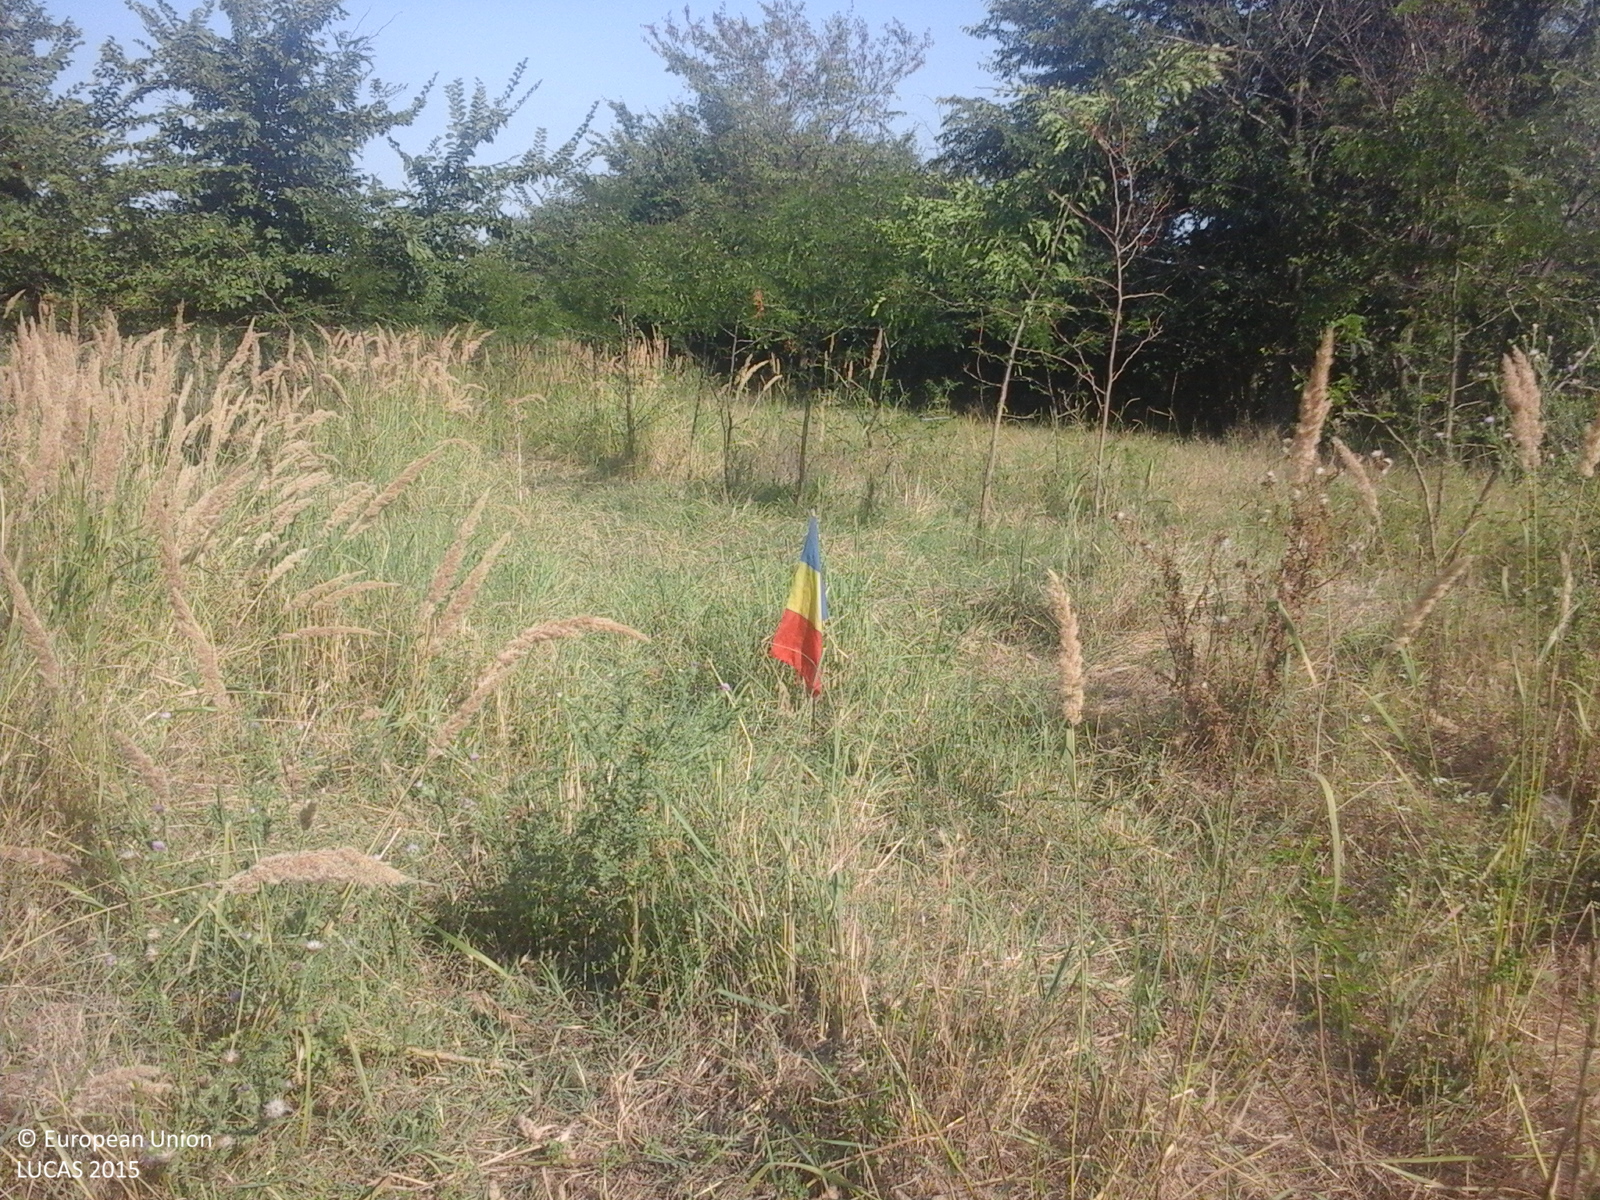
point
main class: Grassland
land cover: Grassland with sparse tree/shrub cover
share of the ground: > 75 %
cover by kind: herbaceous plants 90 %, broadleaved forest trees 5 %, shrubs 5 %
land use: Agriculture (excluding fallow land and kitchen gardens)
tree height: < 5 m
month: July
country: RO
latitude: 44.6319
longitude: 27.6320
